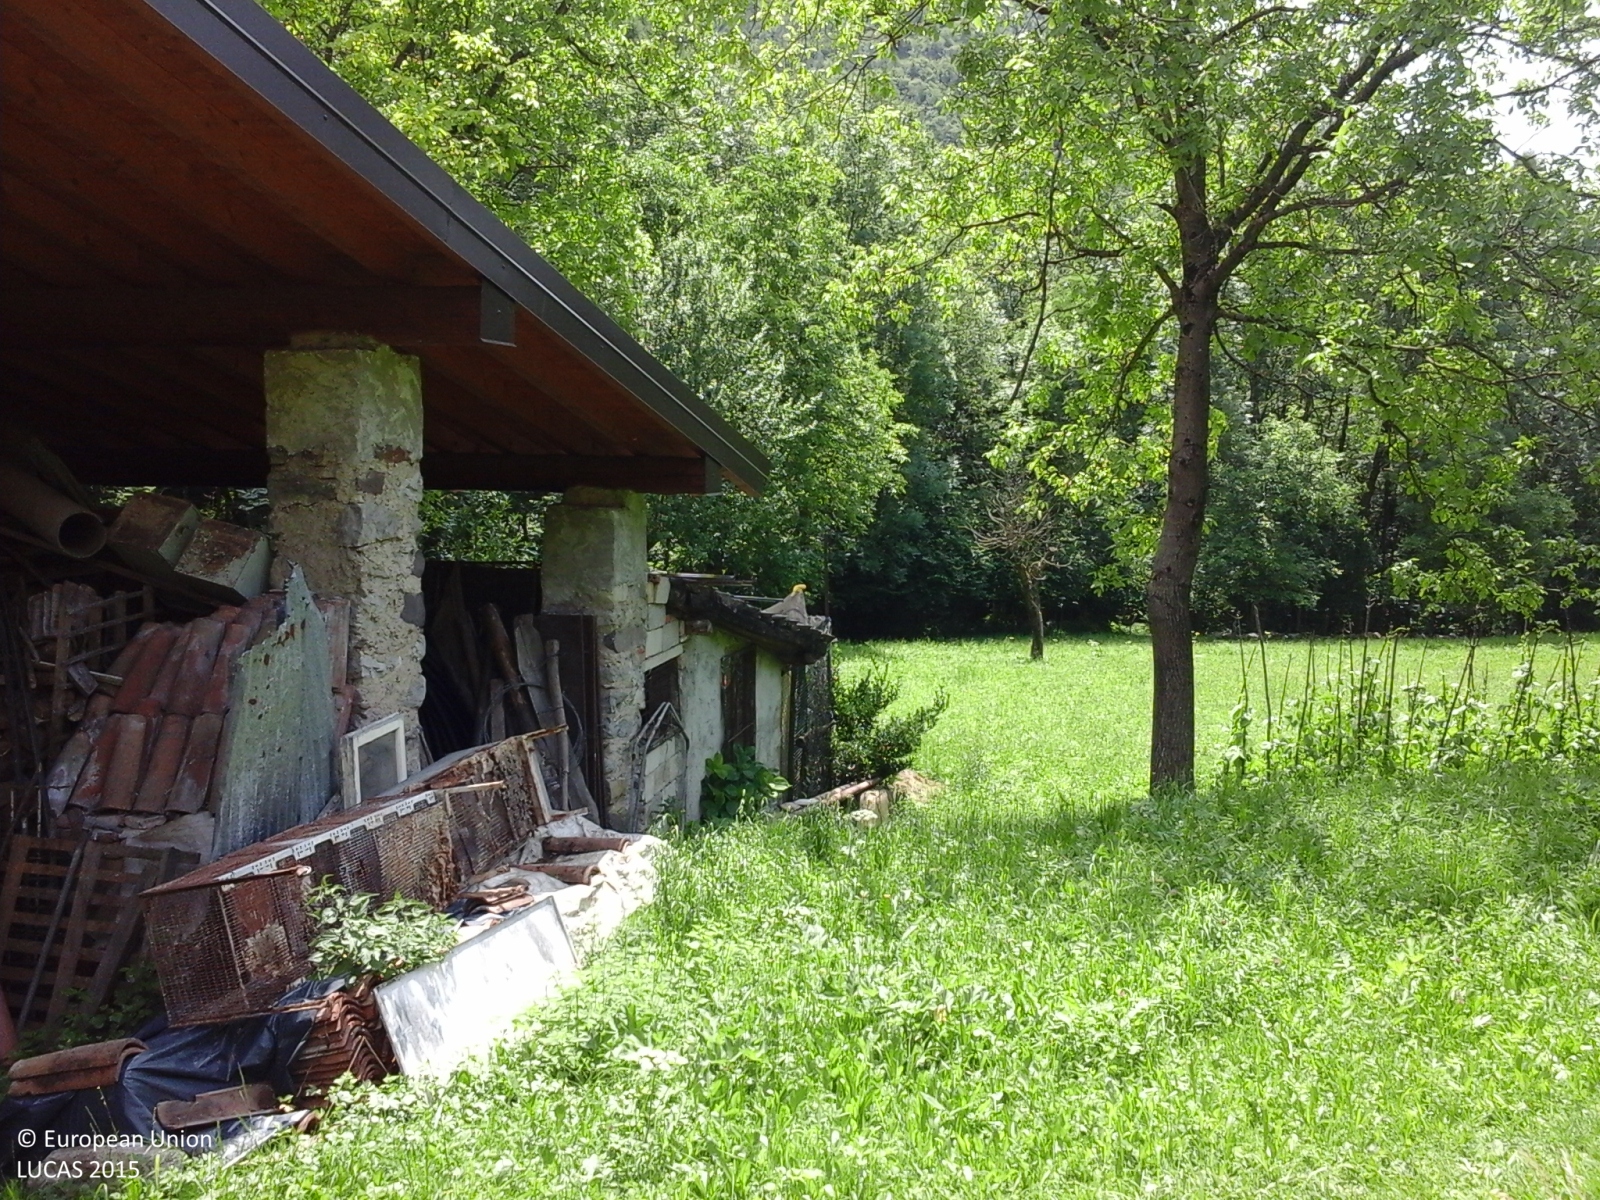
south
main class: Grassland
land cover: Grassland with sparse tree/shrub cover
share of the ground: > 75 %
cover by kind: herbaceous plants 95 %, broadleaved forest trees 5 %
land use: Agriculture (excluding fallow land and kitchen gardens)
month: June
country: IT
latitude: 45.7566
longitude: 10.1155
